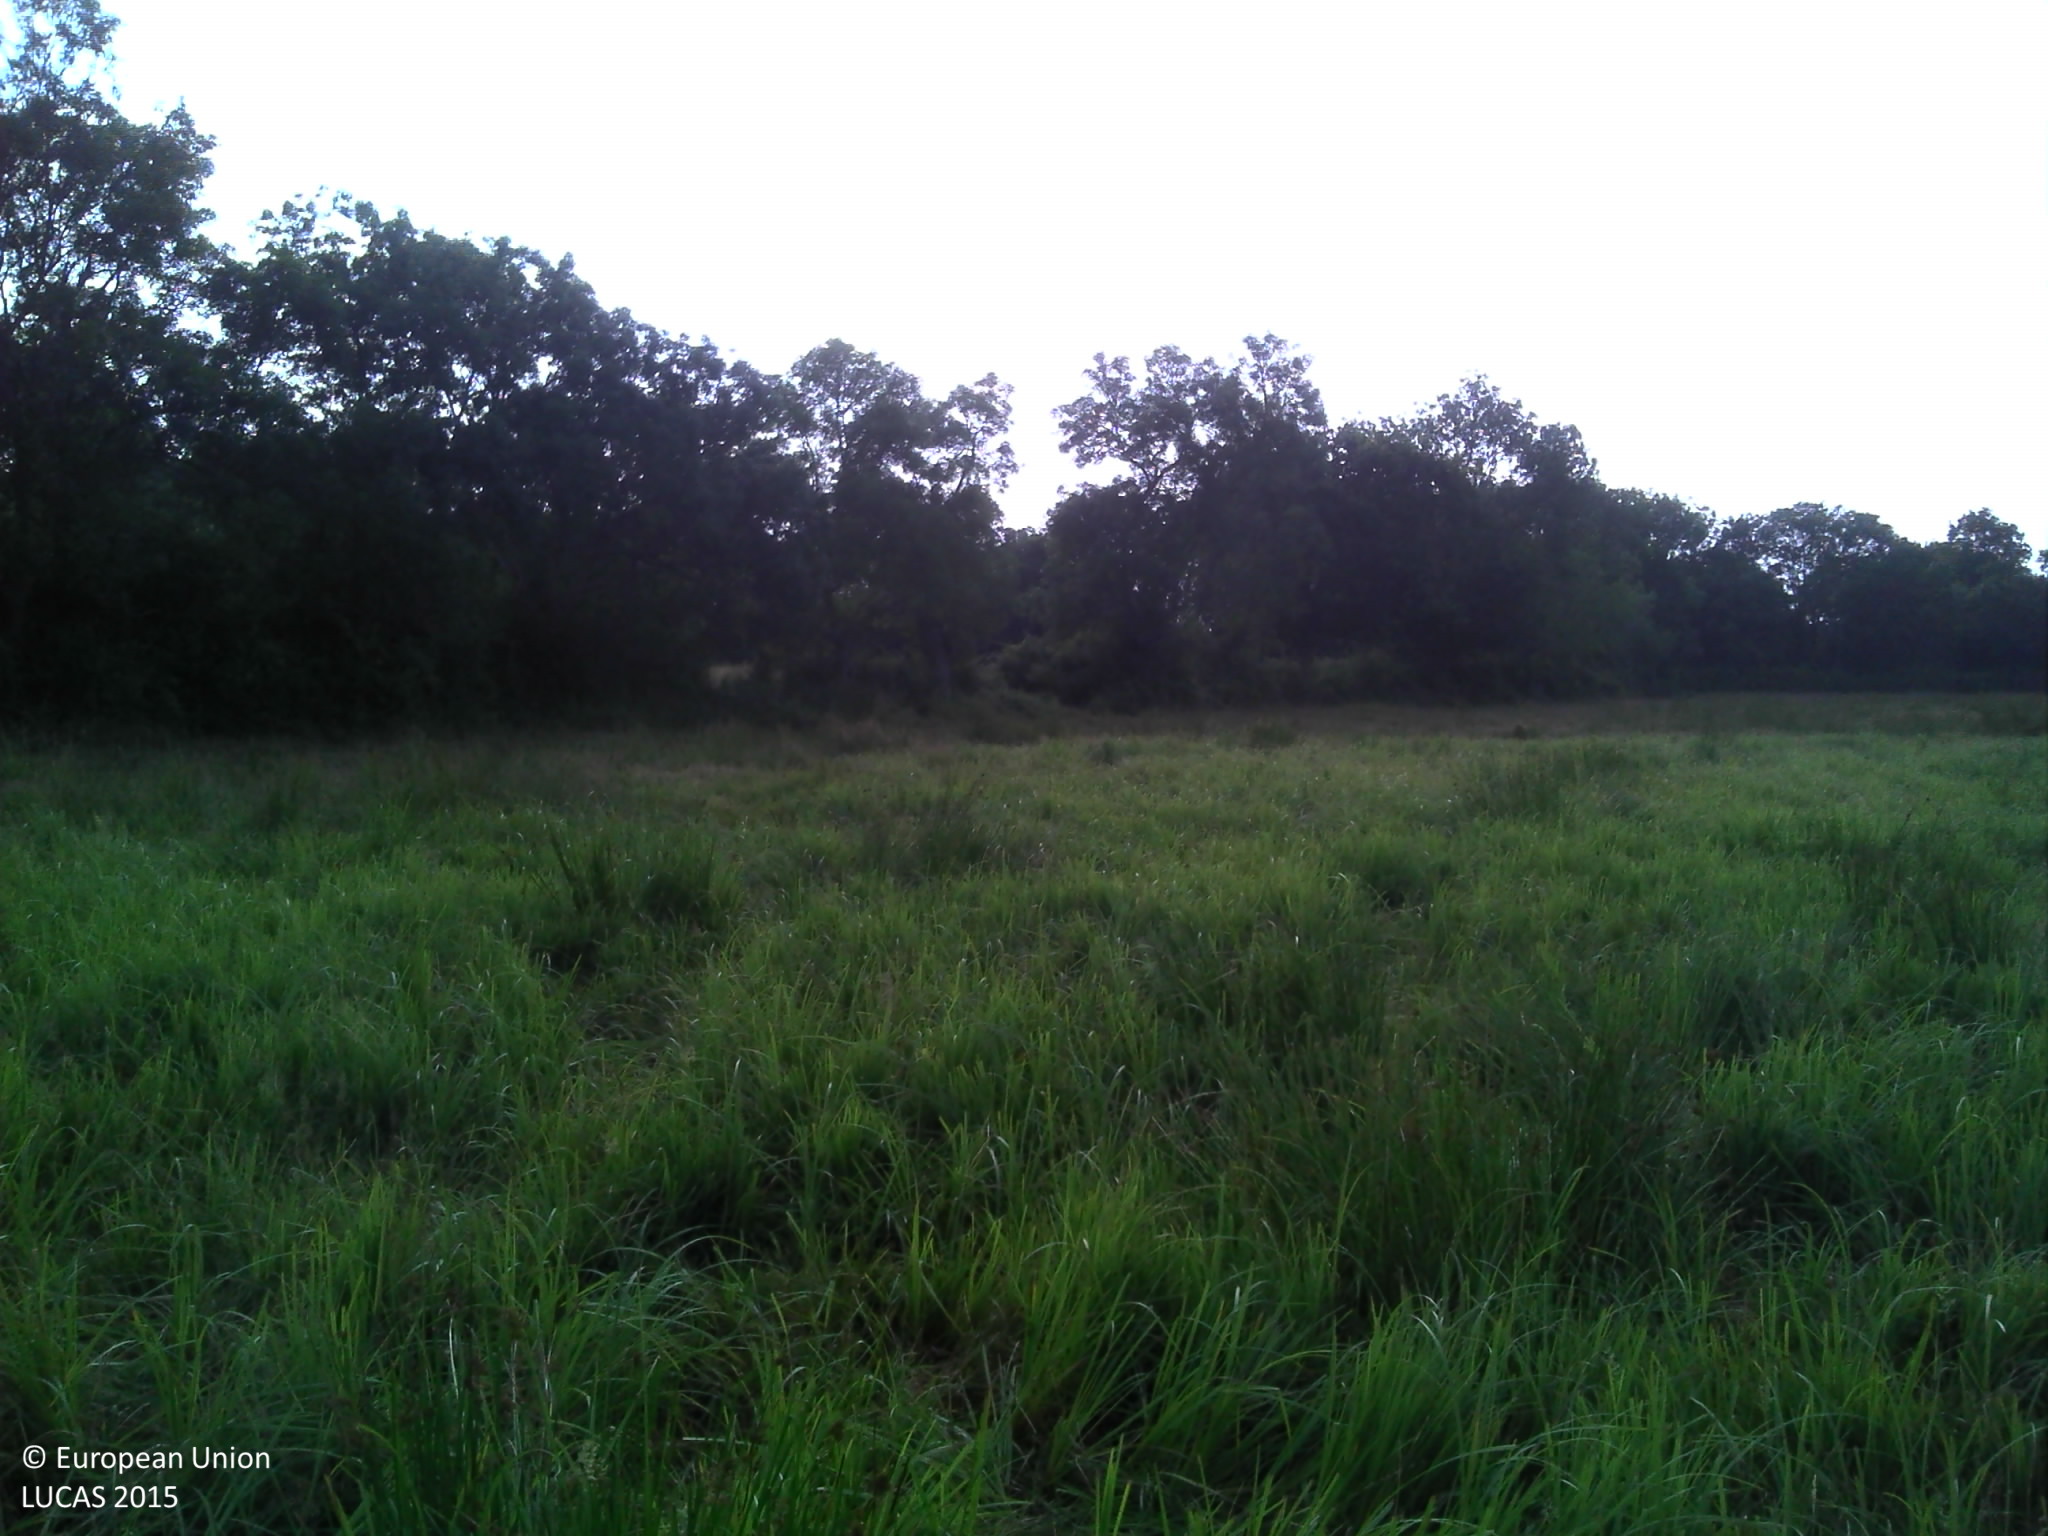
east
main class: Grassland
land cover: Grassland without tree/shrub cover
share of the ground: > 75 %
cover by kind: herbaceous plants 100 %
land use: Agriculture (excluding fallow land and kitchen gardens)
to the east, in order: Grassland without tree/shrub cover; Ditches and canals; Broadleaved woodland; Fences; Grassland without tree/shrub cover; Fences; Broadleaved woodland; Fences; Grassland without tree/shrub cover; Fences; Broadleaved woodland; Grassland without tree/shrub cover; Broadleaved woodland; Grassland without tree/shrub cover
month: July
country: FR
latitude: 47.2903
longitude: -1.8545
